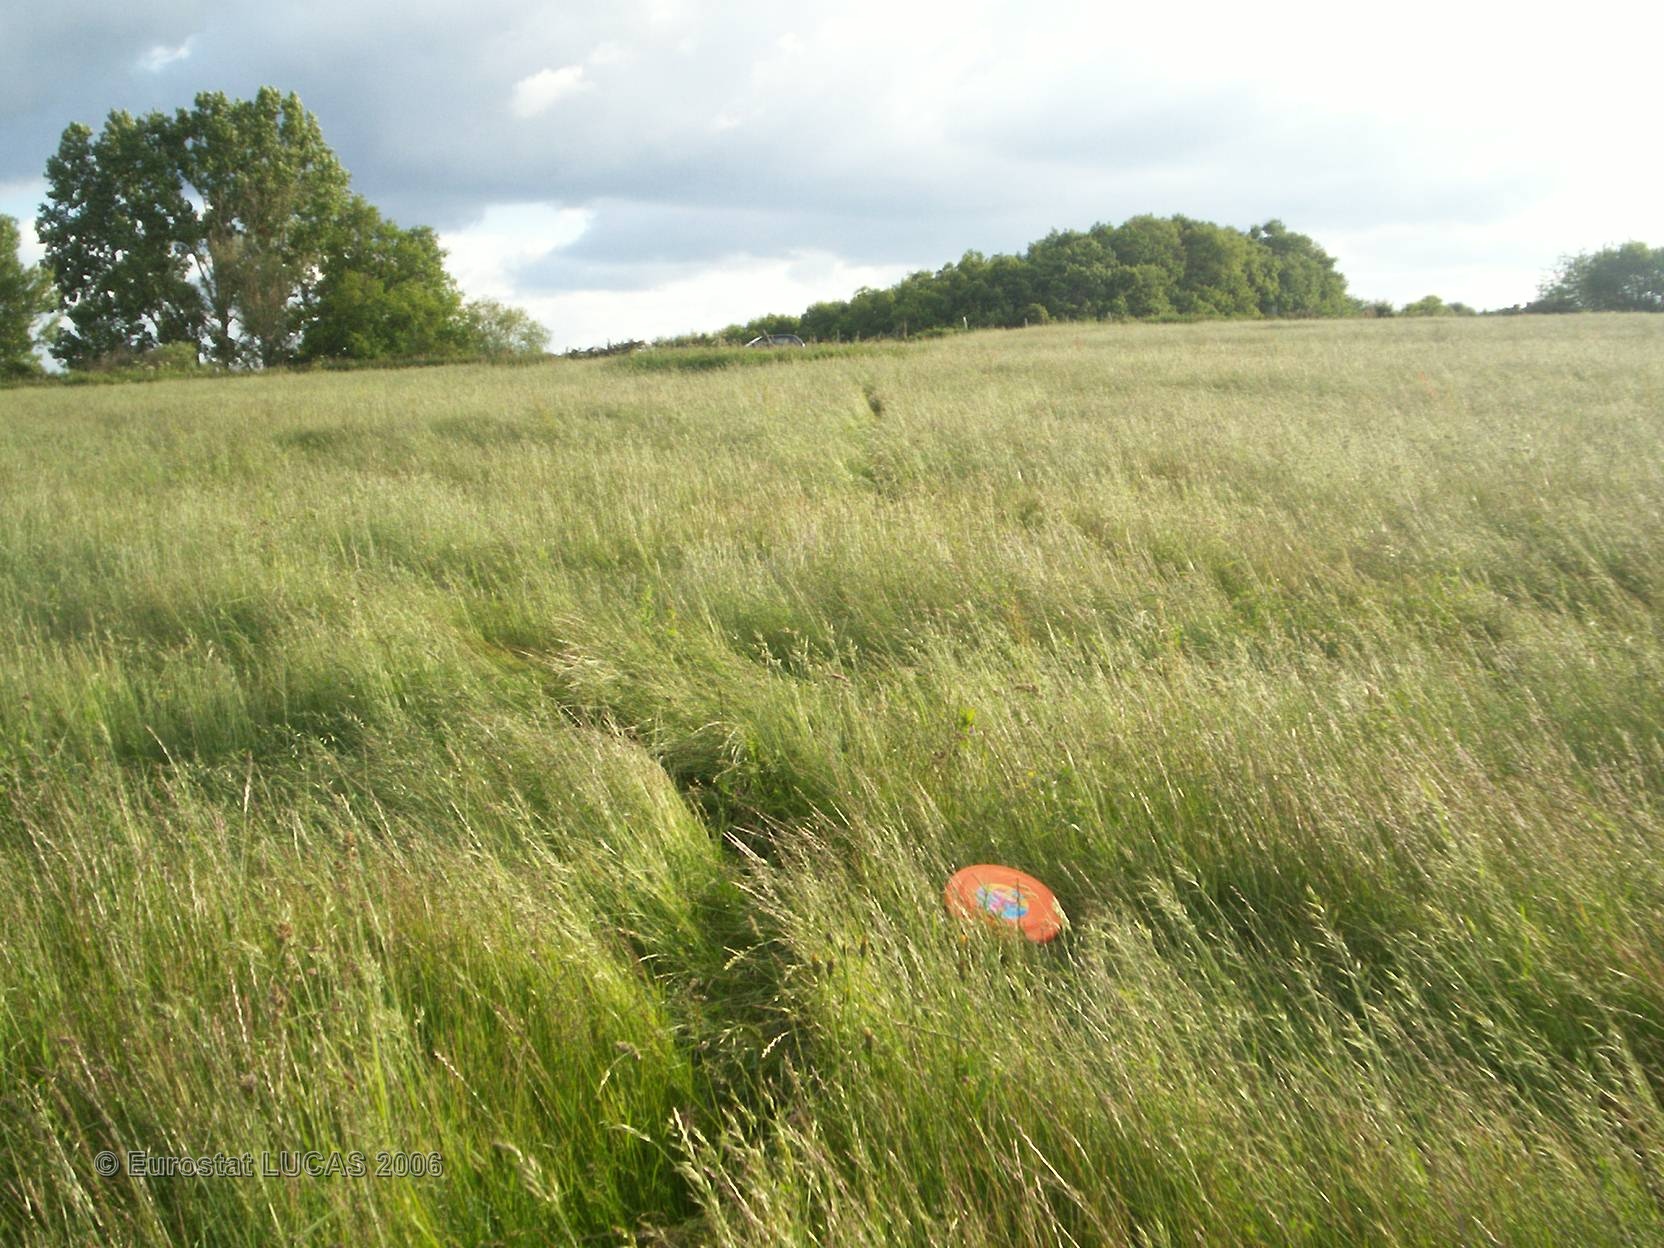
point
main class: Grassland
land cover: Grassland without tree/shrub cover
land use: Agriculture (excluding fallow land and kitchen gardens)
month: June
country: FR
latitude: 46.0958
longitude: 3.1564
